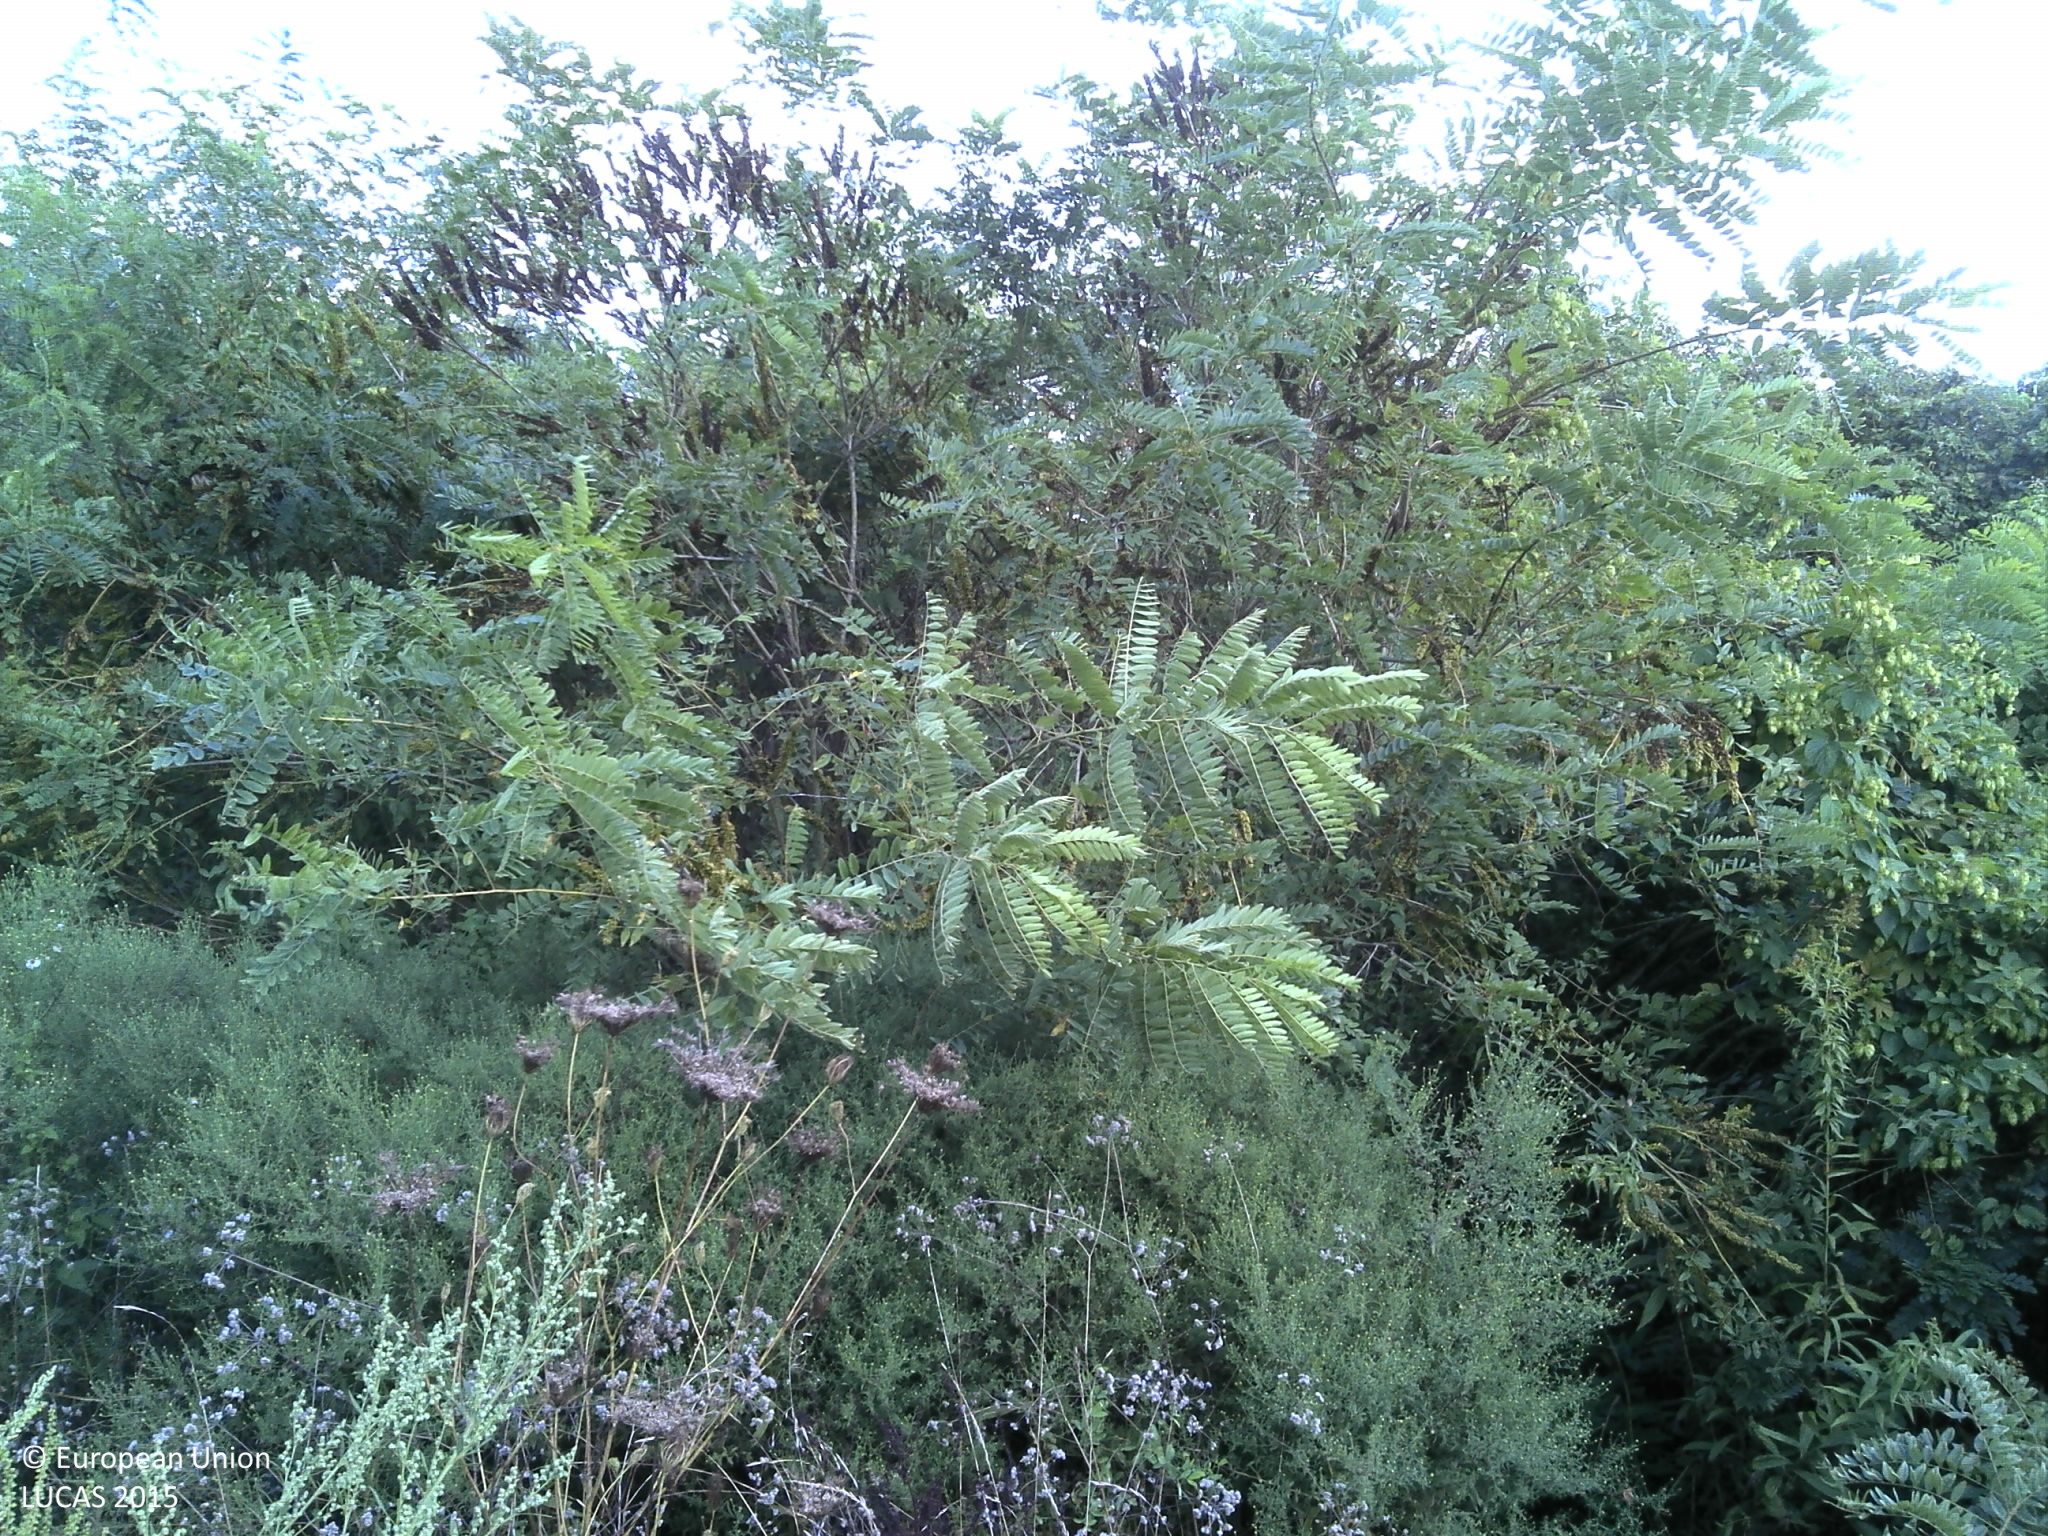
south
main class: Woodland
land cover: Broadleaved woodland
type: acidophilous oak and oak-birch forest
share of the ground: > 75 %
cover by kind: broadleaved forest trees 100 %
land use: Forestry
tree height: > 5 m
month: September
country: HR
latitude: 45.7165
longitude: 18.5767
